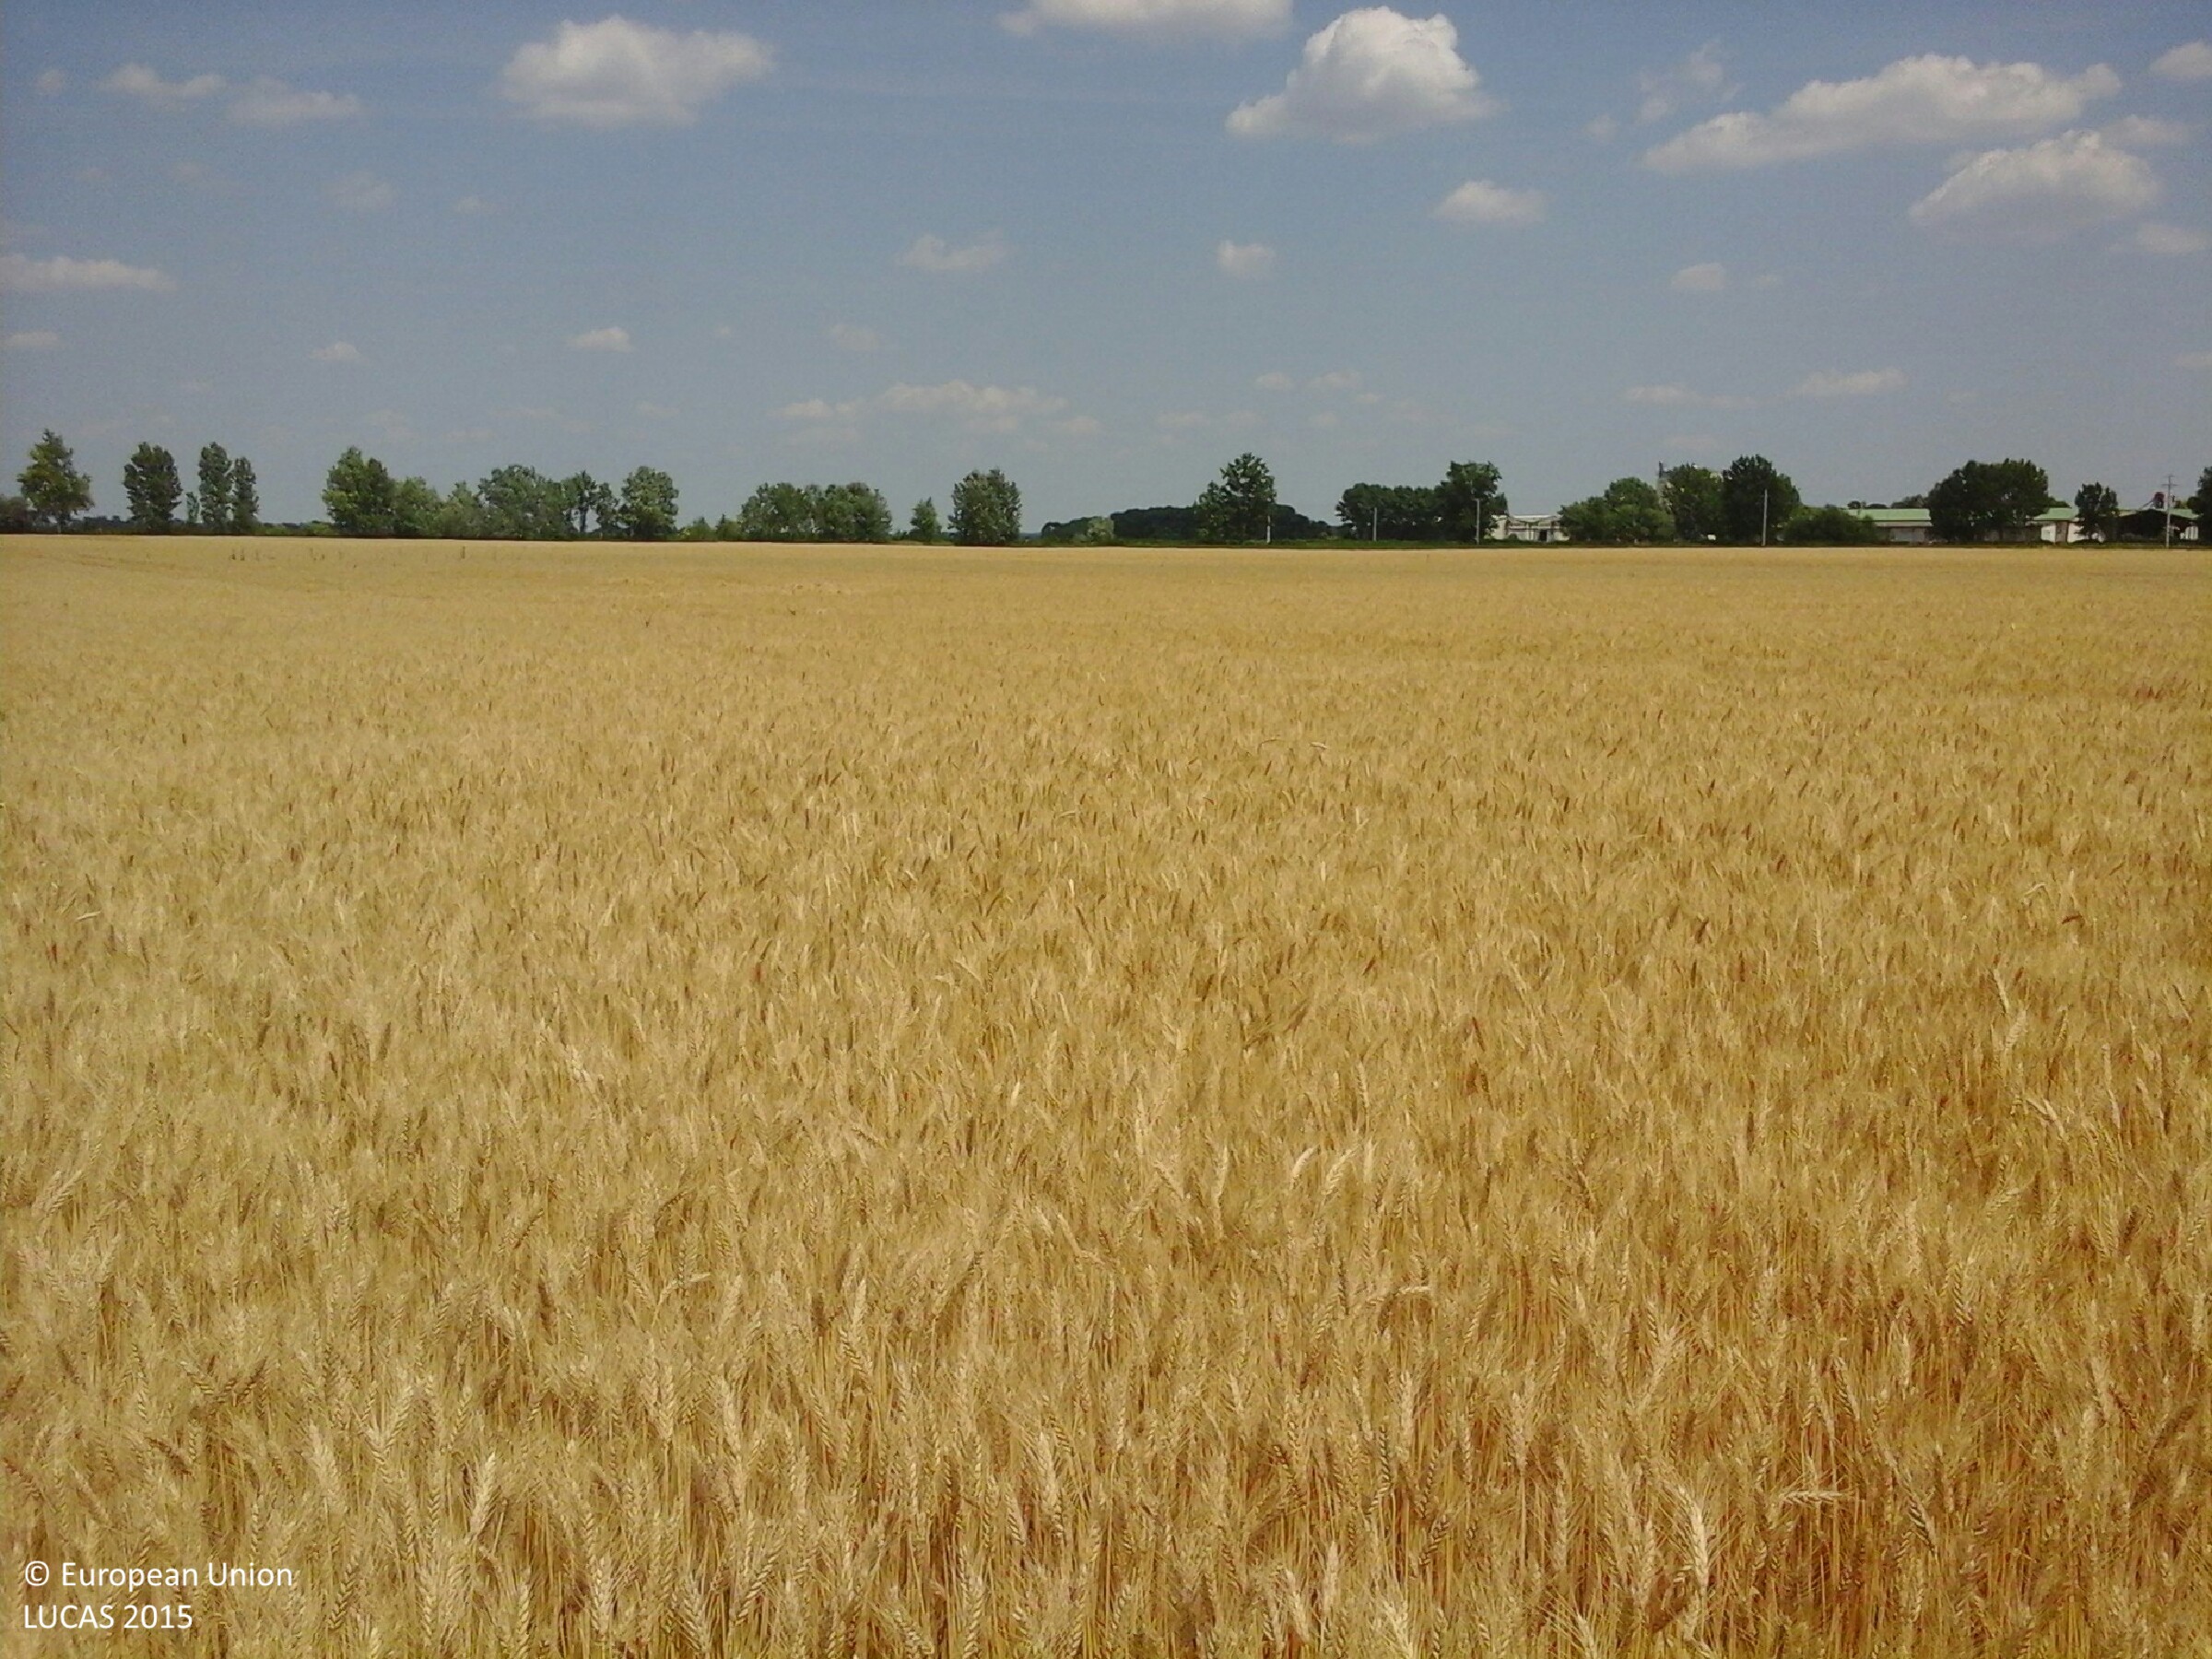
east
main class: Cropland
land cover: Common wheat
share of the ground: > 75 %
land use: Agriculture (excluding fallow land and kitchen gardens)
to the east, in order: Common wheat
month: July
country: HU
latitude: 47.7767
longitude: 20.6703
